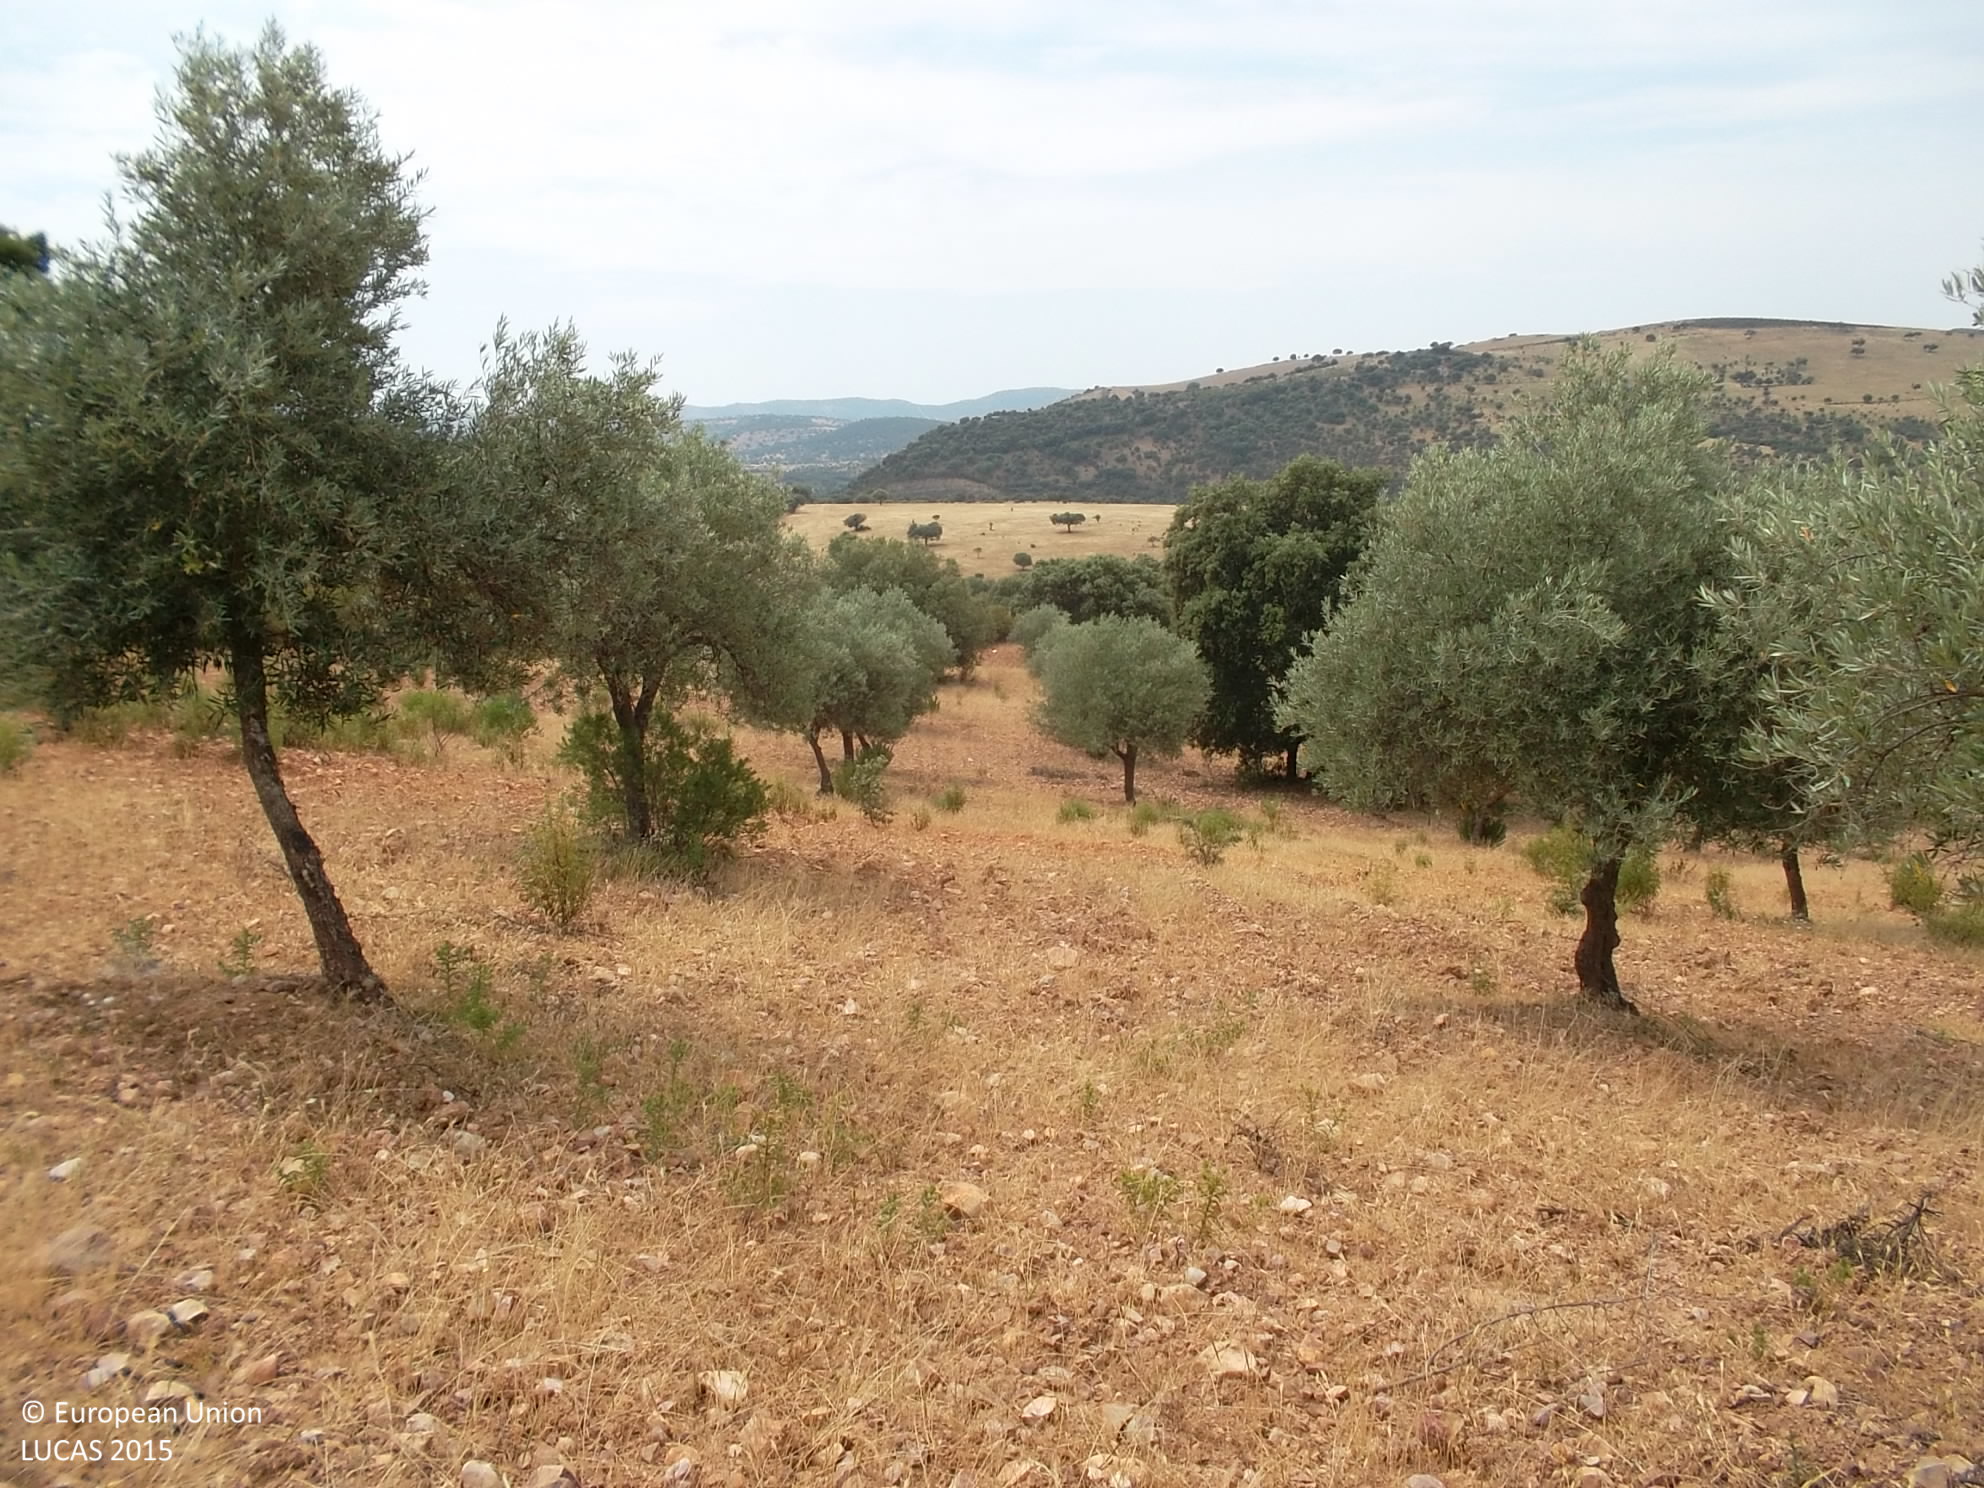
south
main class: Cropland
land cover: Olive groves
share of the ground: 25 - 50 %
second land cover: Spontaneously vegetated surfaces
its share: 10 - 25 %
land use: Agriculture (excluding fallow land and kitchen gardens)
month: June
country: ES
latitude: 39.1261
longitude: -4.8765
